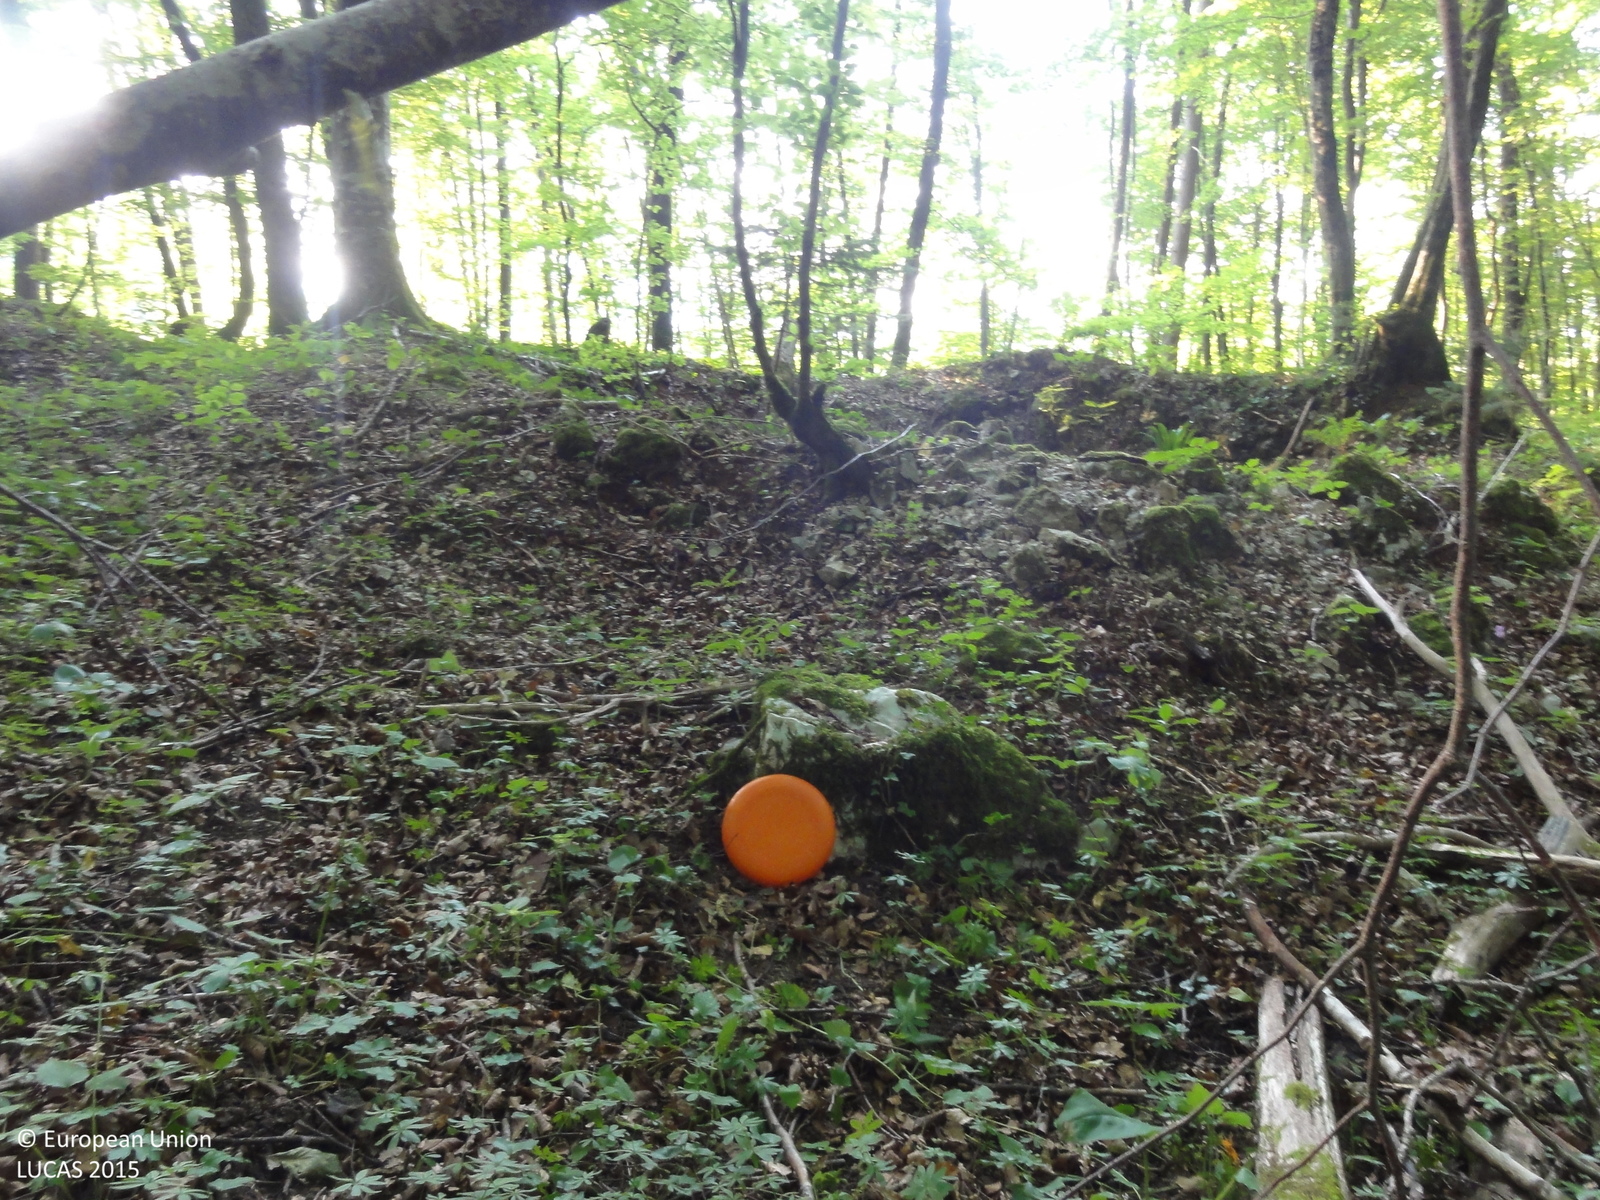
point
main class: Woodland
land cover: Broadleaved woodland
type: beech forest
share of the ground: > 75 %
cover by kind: broadleaved forest trees 95 %, coniferous forest trees 5 %
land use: Forestry
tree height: > 5 m
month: August
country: SI
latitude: 45.8370
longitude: 15.0047
